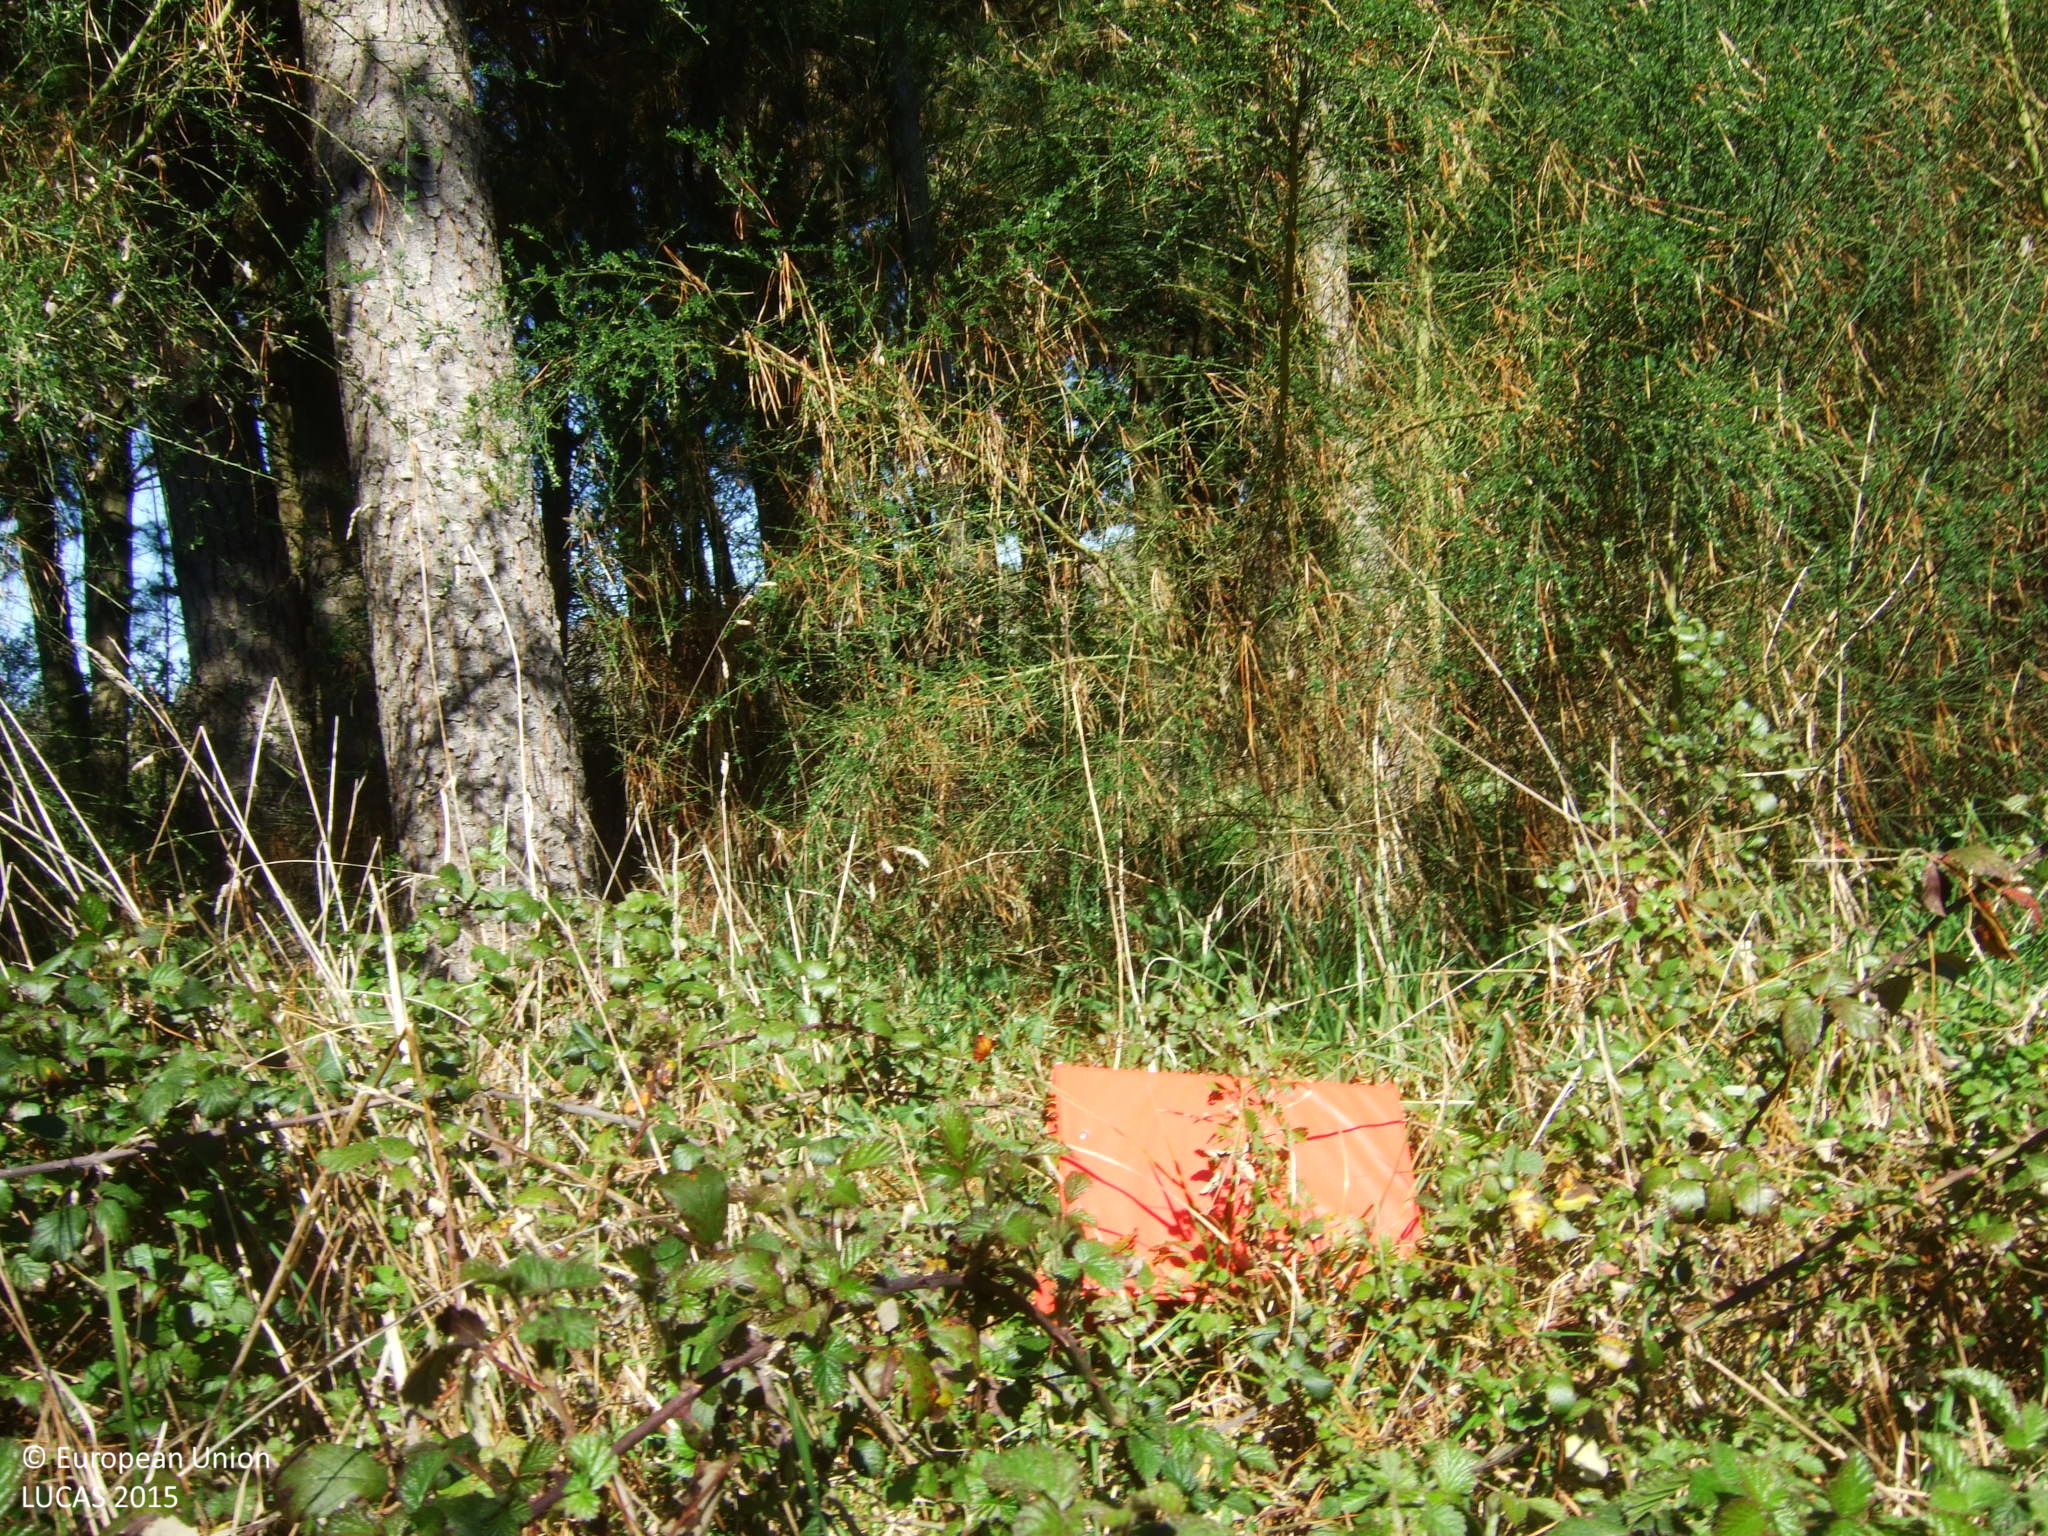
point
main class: Shrubland
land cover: Shrubland with sparse tree cover
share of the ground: > 75 %
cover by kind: shrubs 85 %, herbaceous plants 10 %, broadleaved forest trees 5 %
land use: Semi-natural and natural areas not in use
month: April
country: ES
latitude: 42.7967
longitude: -7.7975
